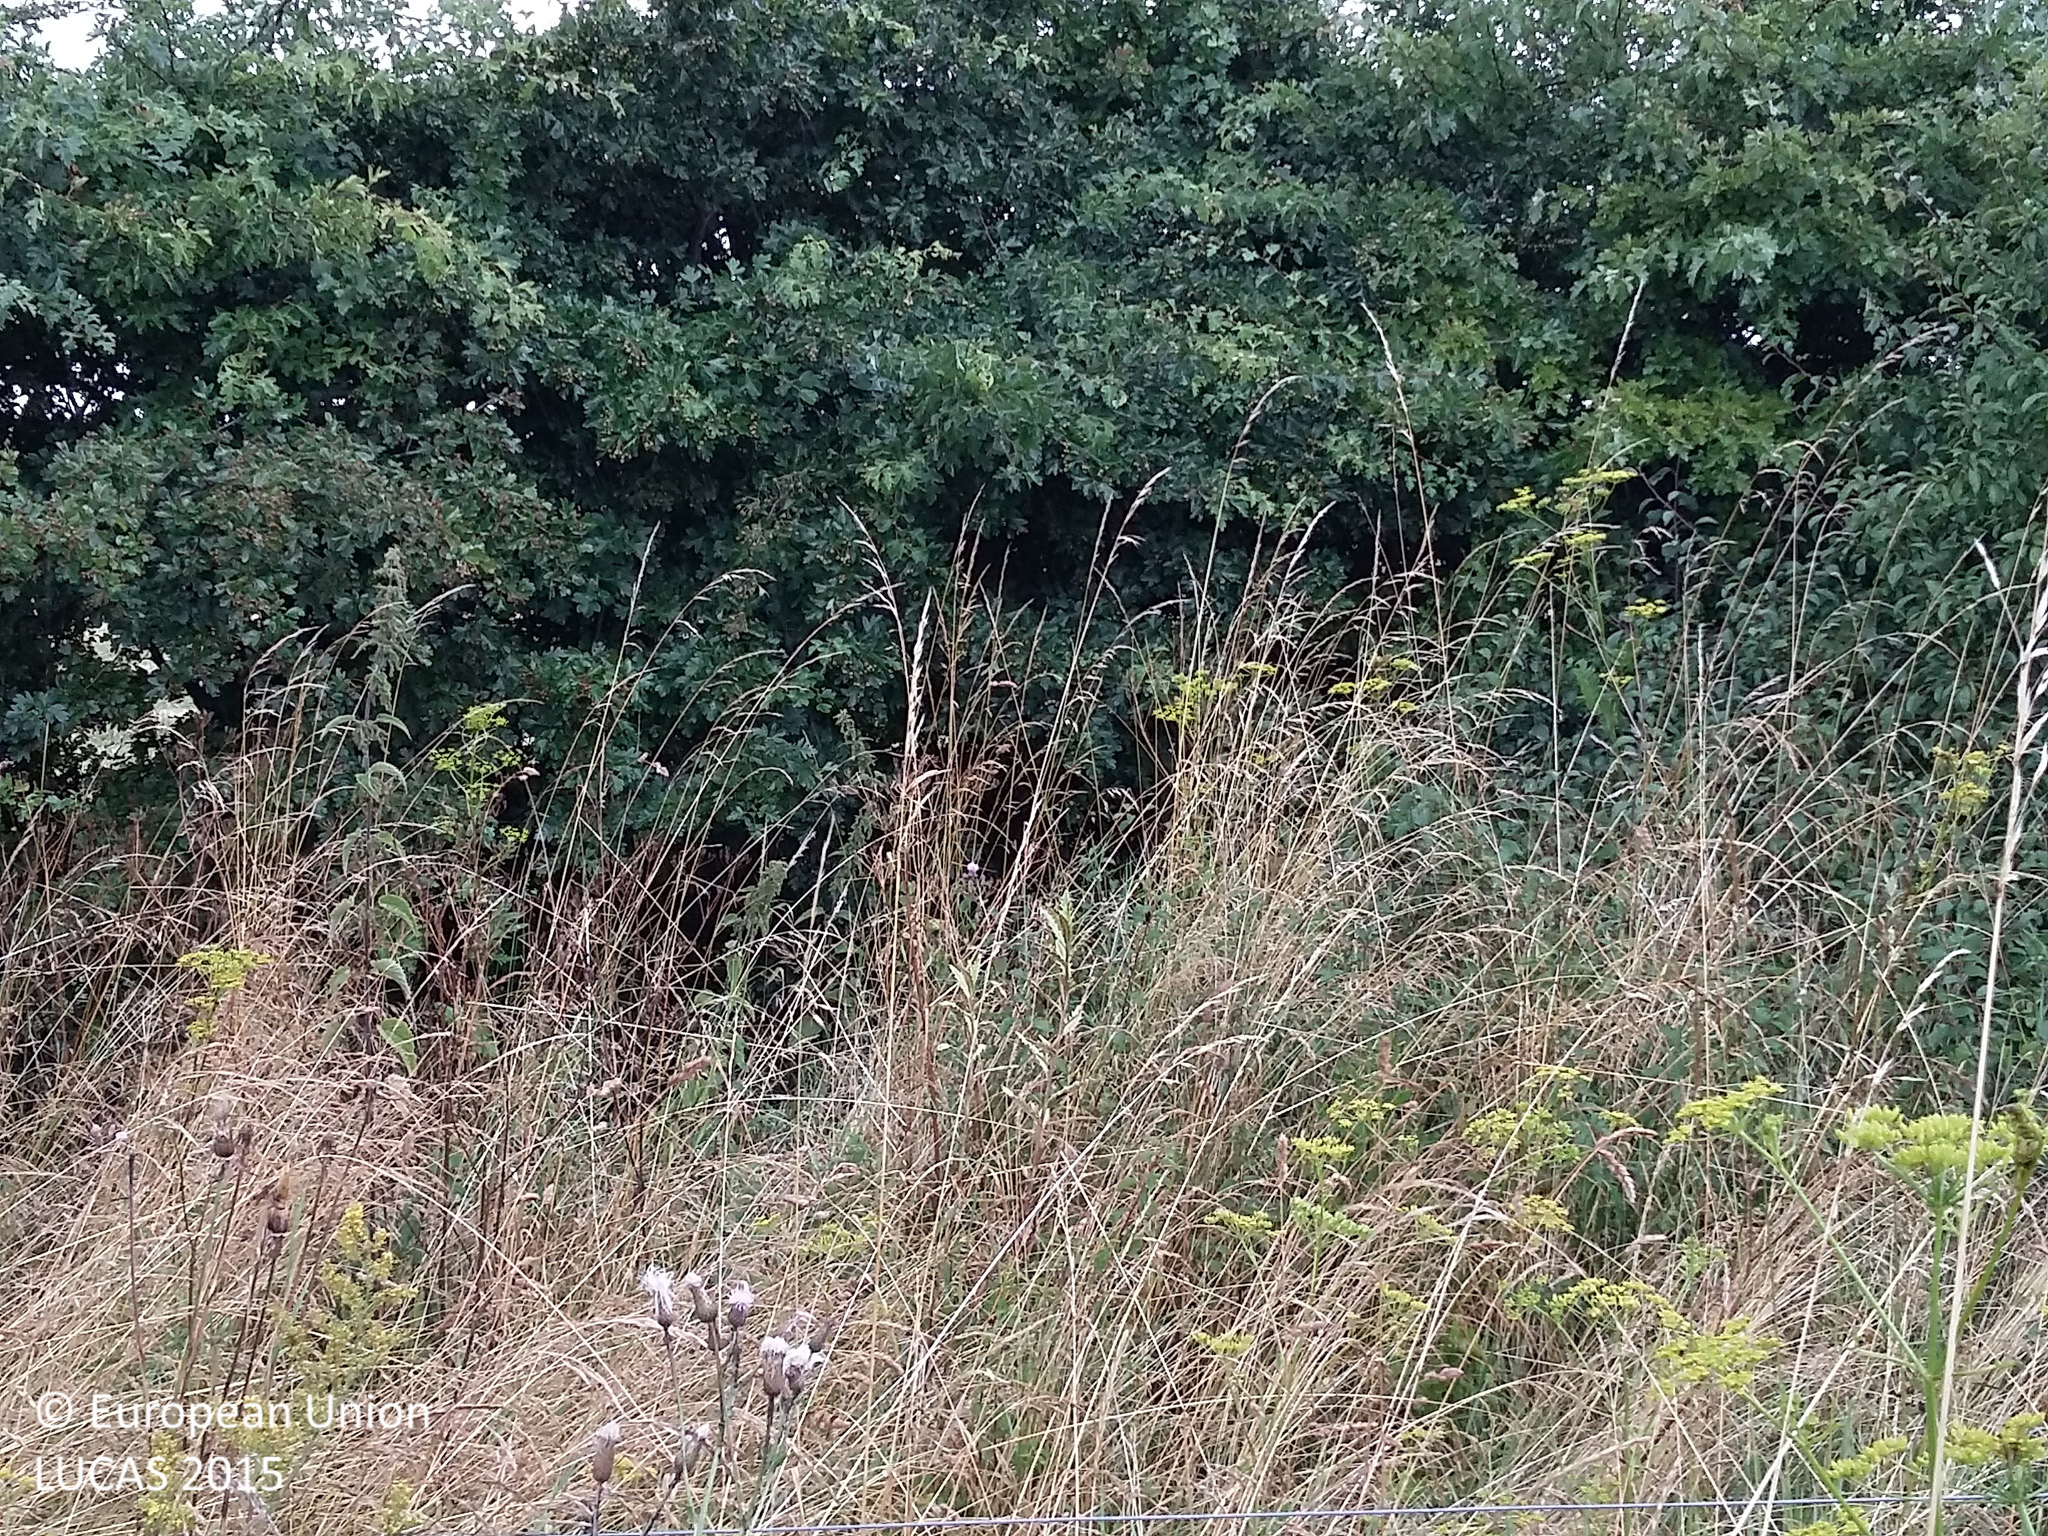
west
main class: Grassland
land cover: Spontaneously vegetated surfaces
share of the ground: > 75 %
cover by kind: herbaceous plants 100 %
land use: Semi-natural and natural areas not in use
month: July
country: DK
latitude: 55.9015
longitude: 12.0613
